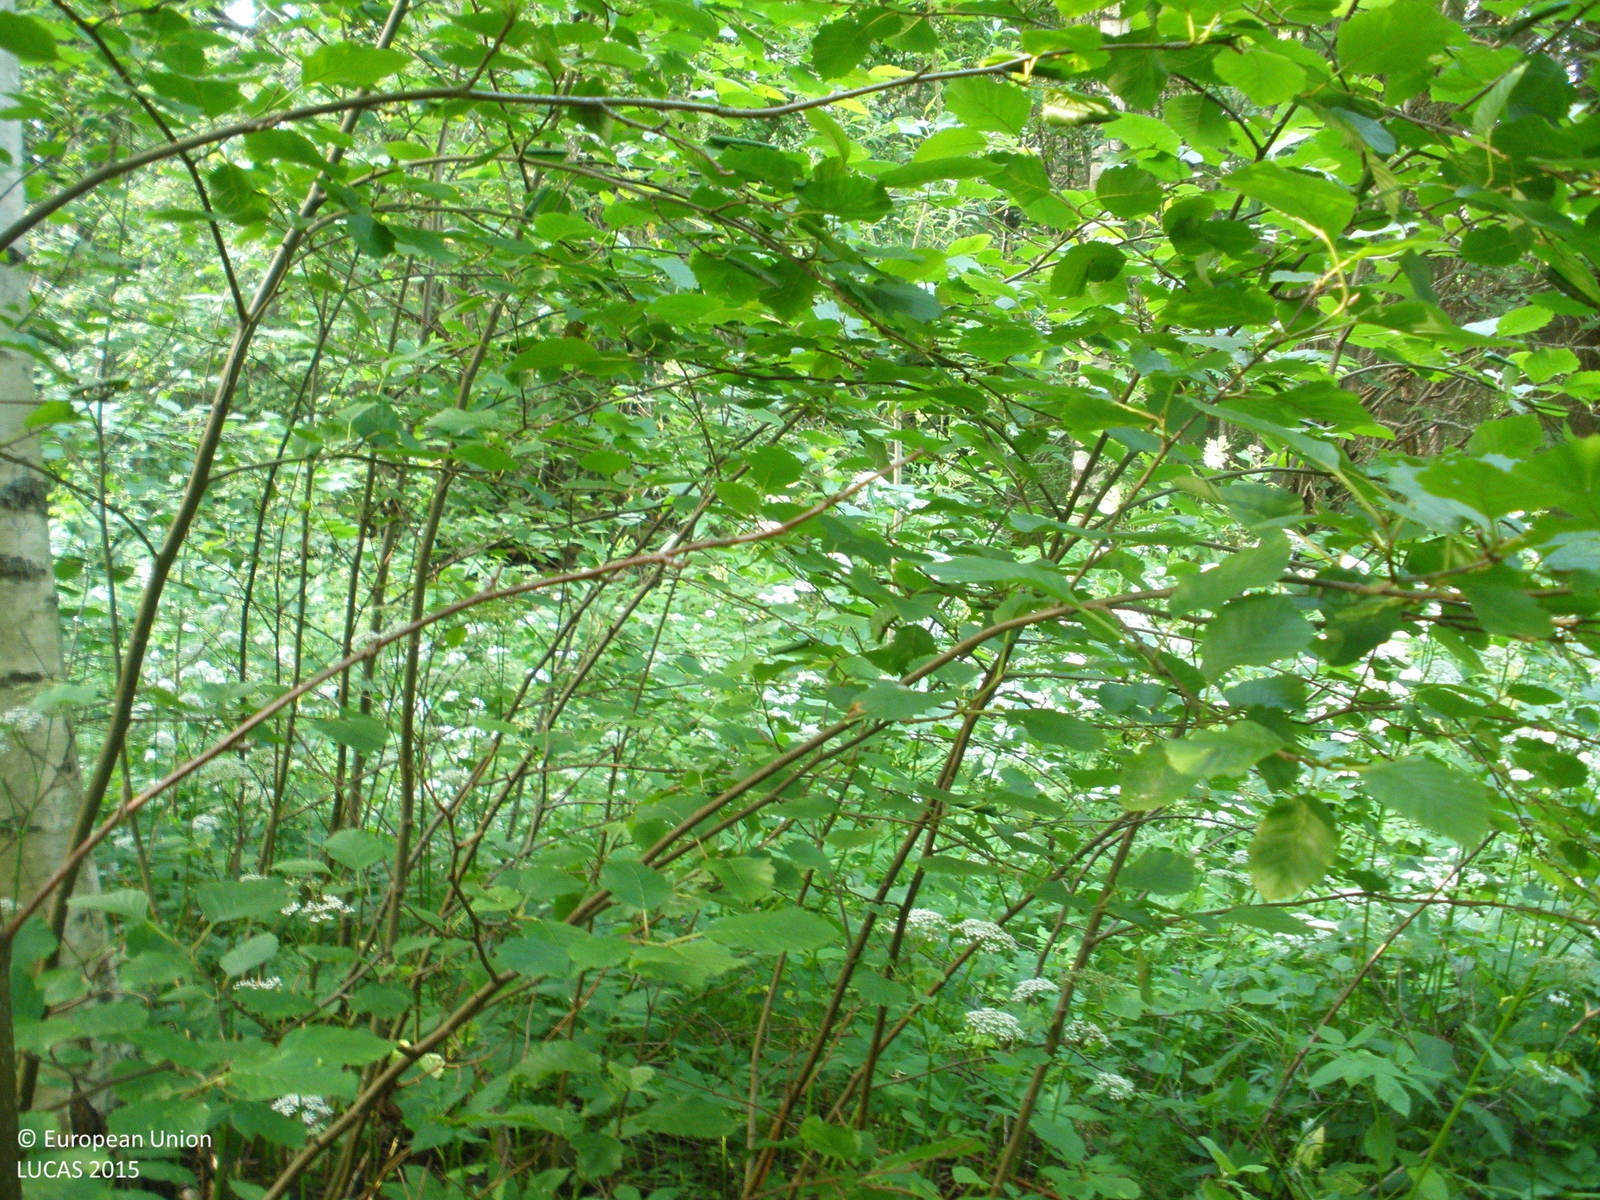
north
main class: Woodland
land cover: Broadleaved woodland
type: non-riverine alder, birch or aspen forest
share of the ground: > 75 %
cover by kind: broadleaved forest trees 85 %, shrubs 10 %, herbaceous plants 5 %
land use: Forestry
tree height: > 5 m
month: July
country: FI
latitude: 61.4027
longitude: 24.0045
